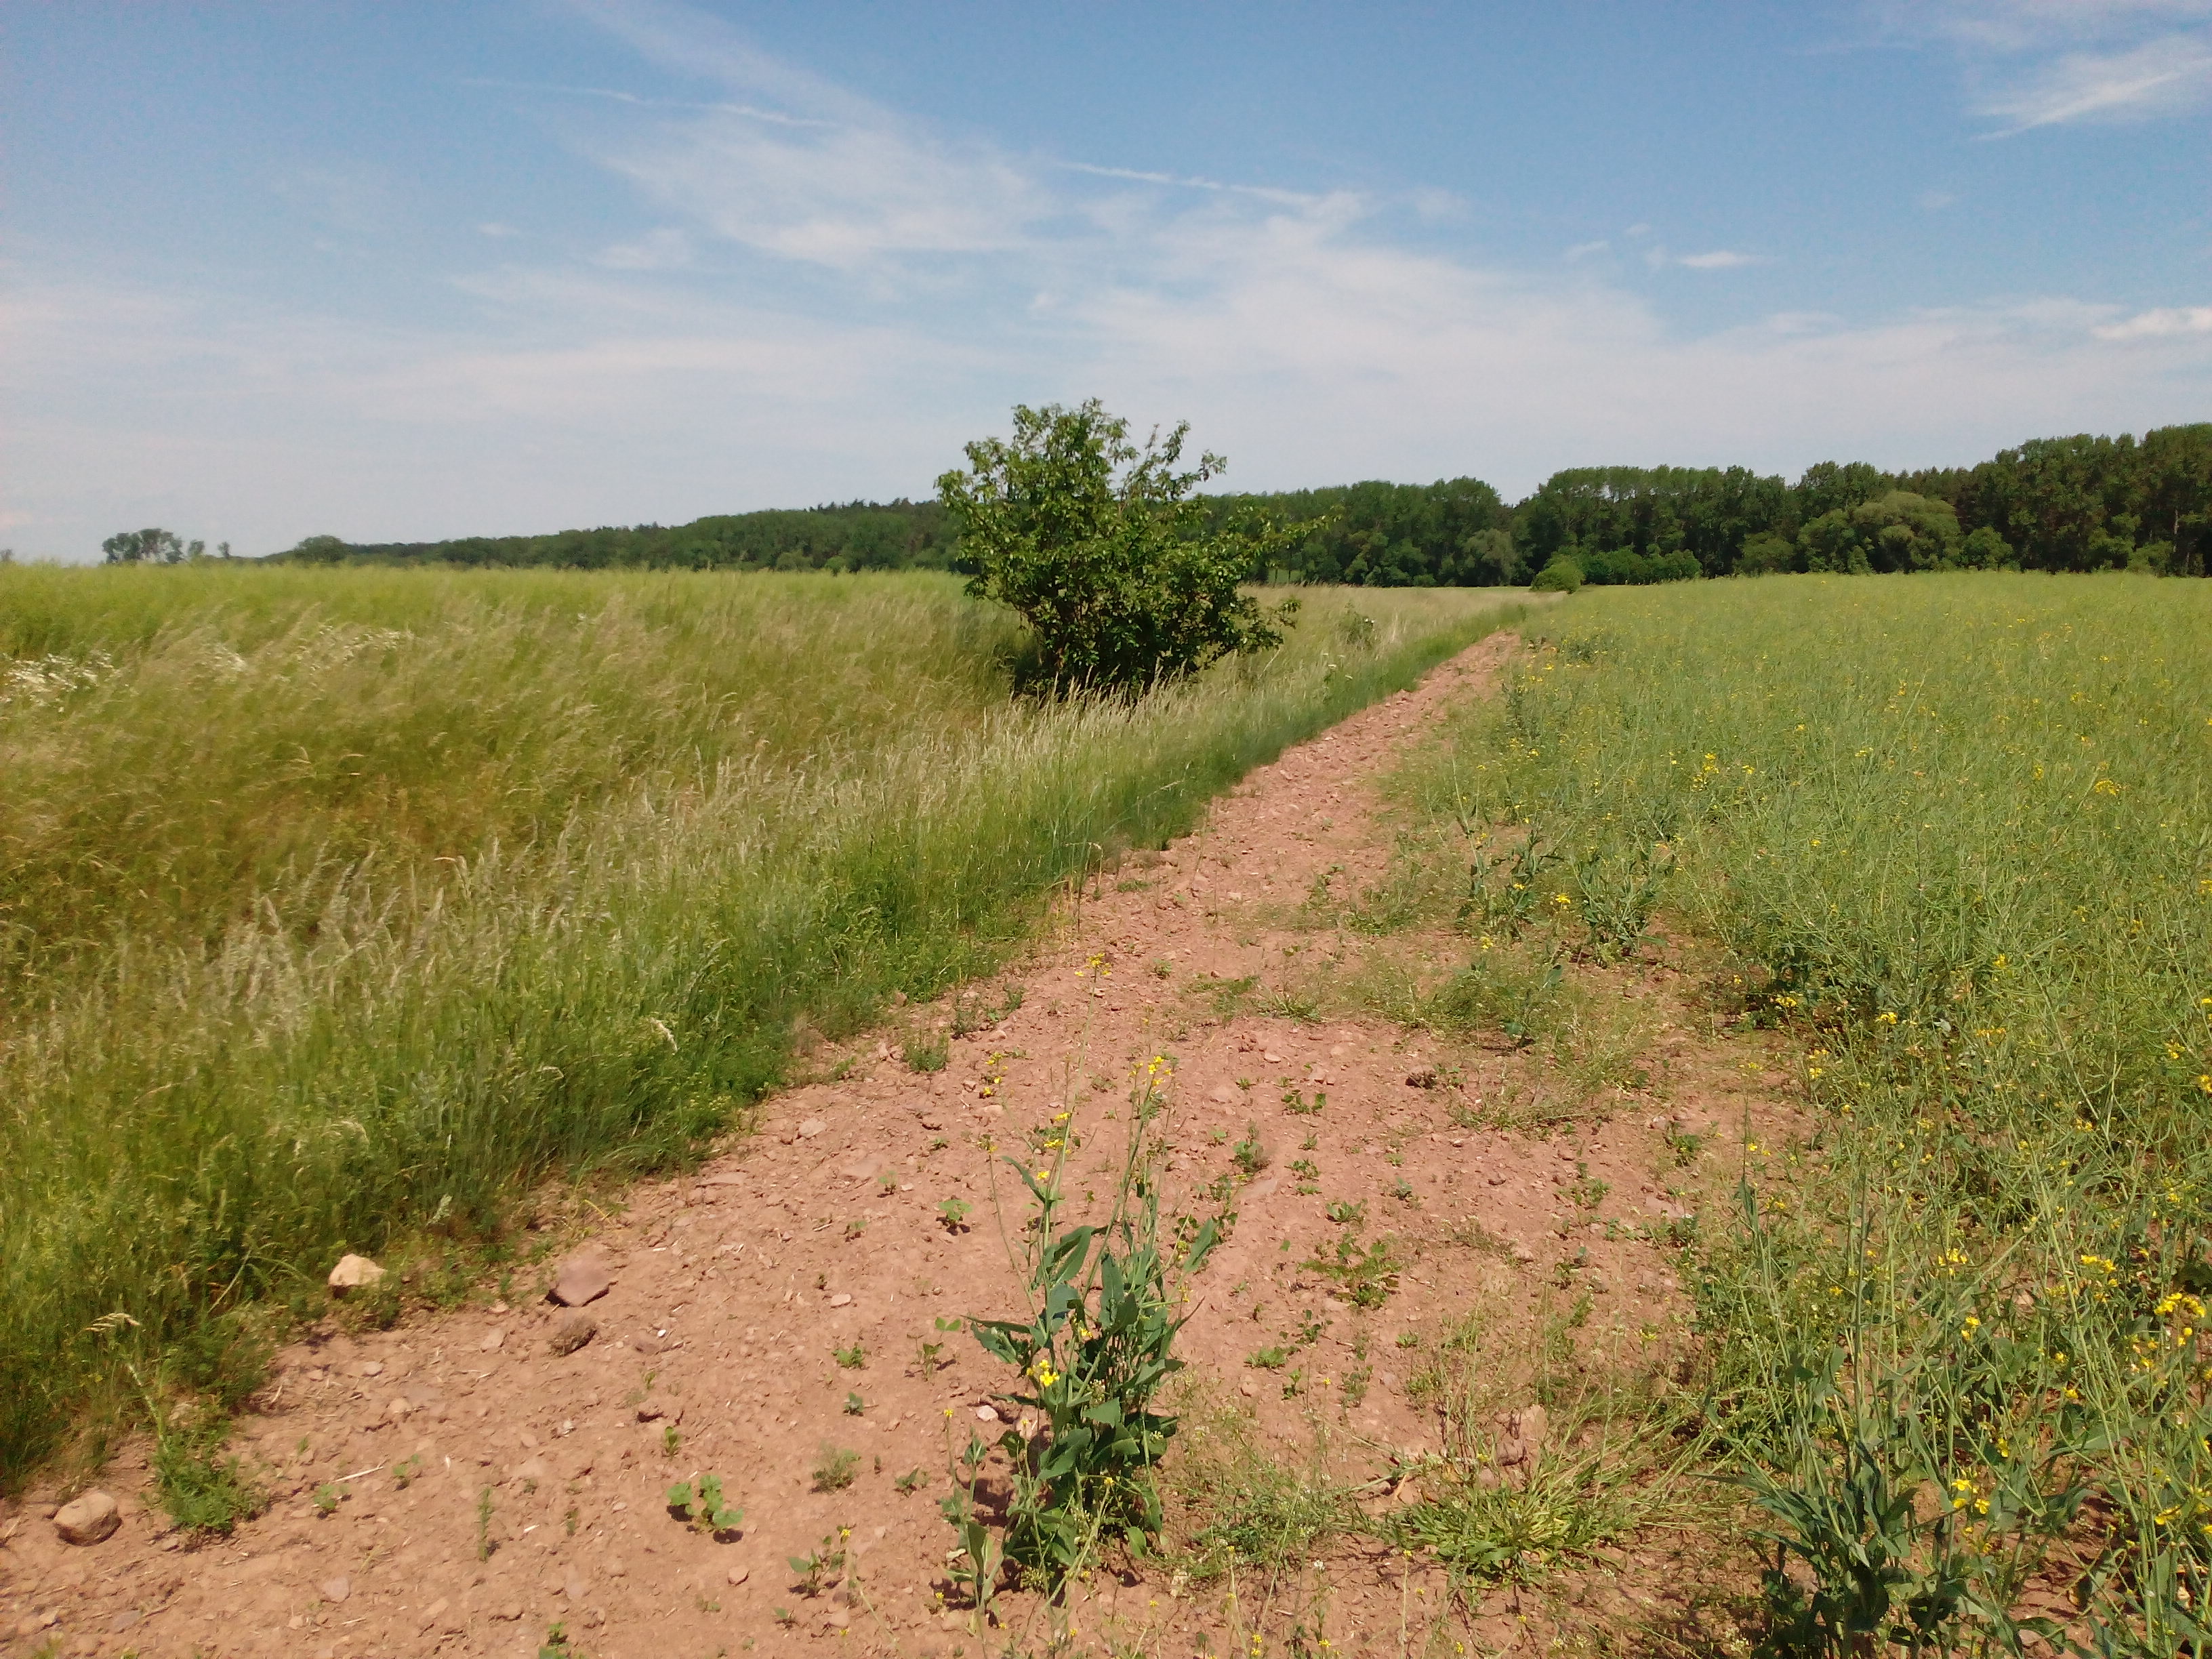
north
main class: Cropland
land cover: Rape and turnip rape
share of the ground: > 75 %
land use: Agriculture (excluding fallow land and kitchen gardens)
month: June
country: DE
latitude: 50.8657
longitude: 10.6392
